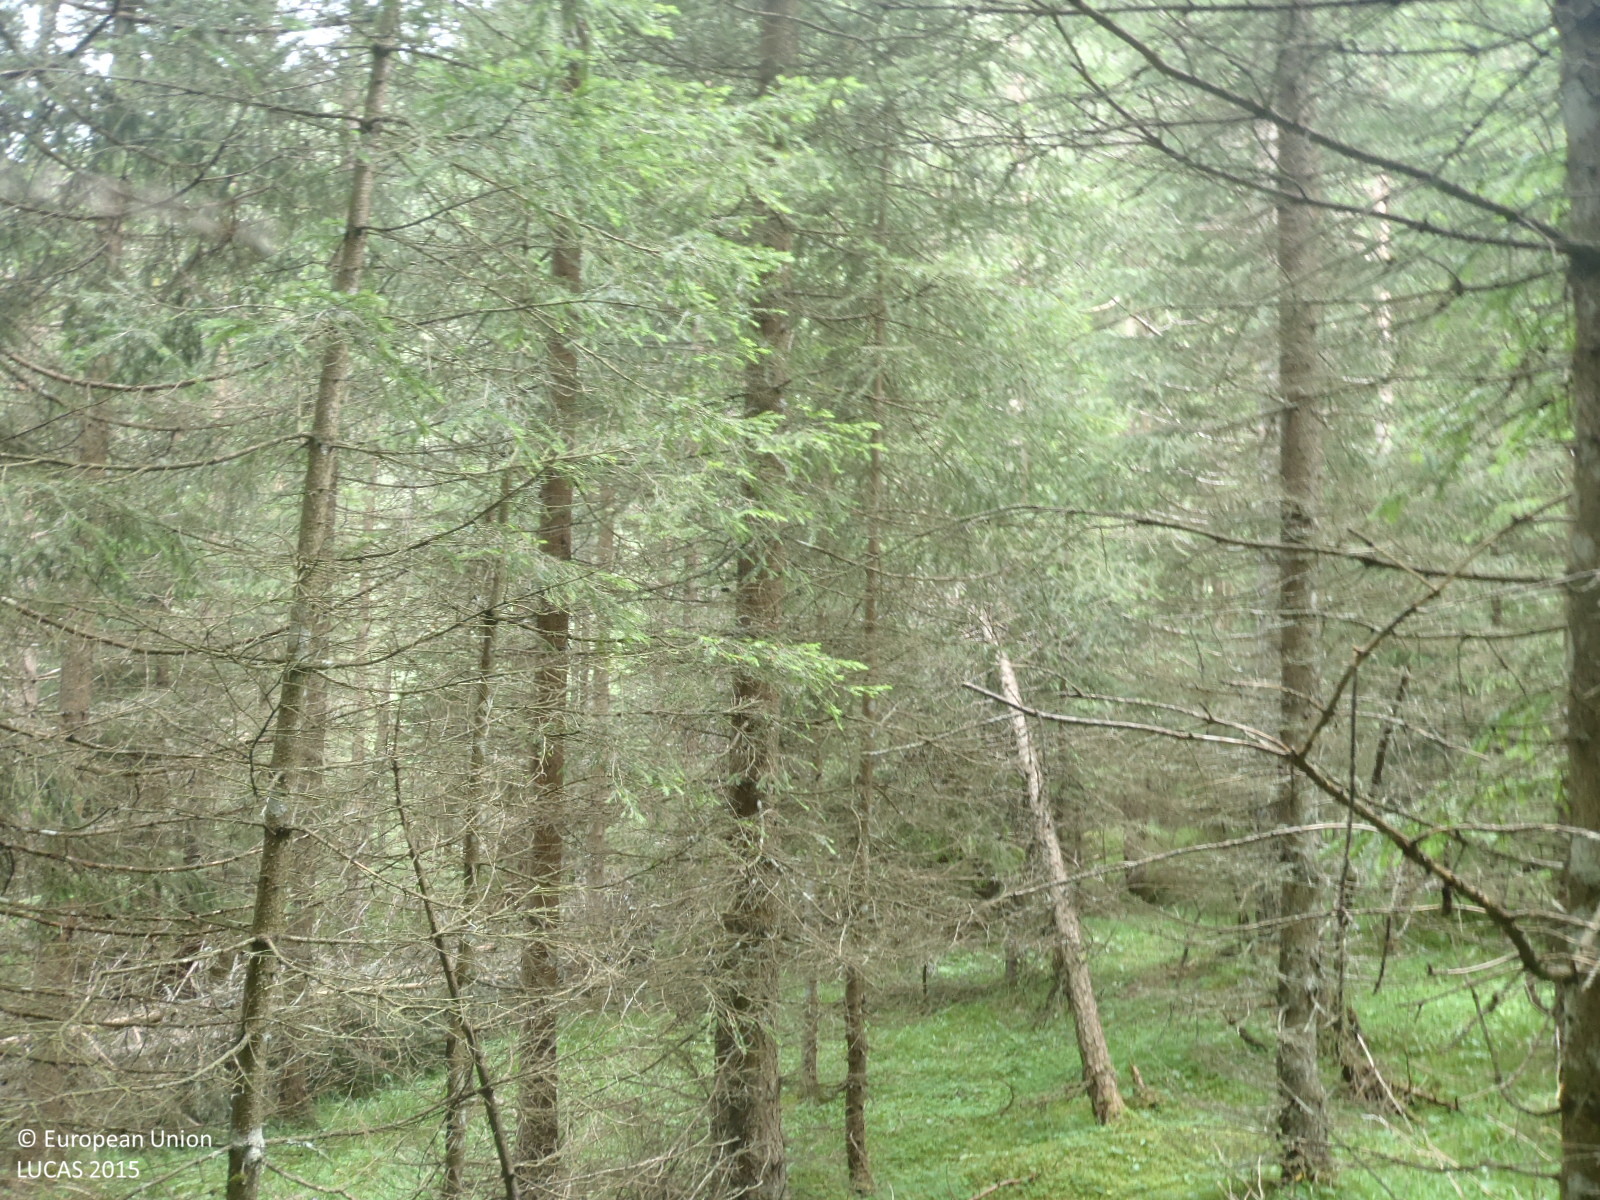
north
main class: Woodland
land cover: Spruce dominated coniferous woodland
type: alpine coniferous forest
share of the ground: > 75 %
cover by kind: coniferous forest trees 75 %, herbaceous plants 10 %, lichens and mosses 10 %, shrubs 5 %
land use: Forestry
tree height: > 5 m
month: July
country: AT
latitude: 47.3198
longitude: 10.9120
